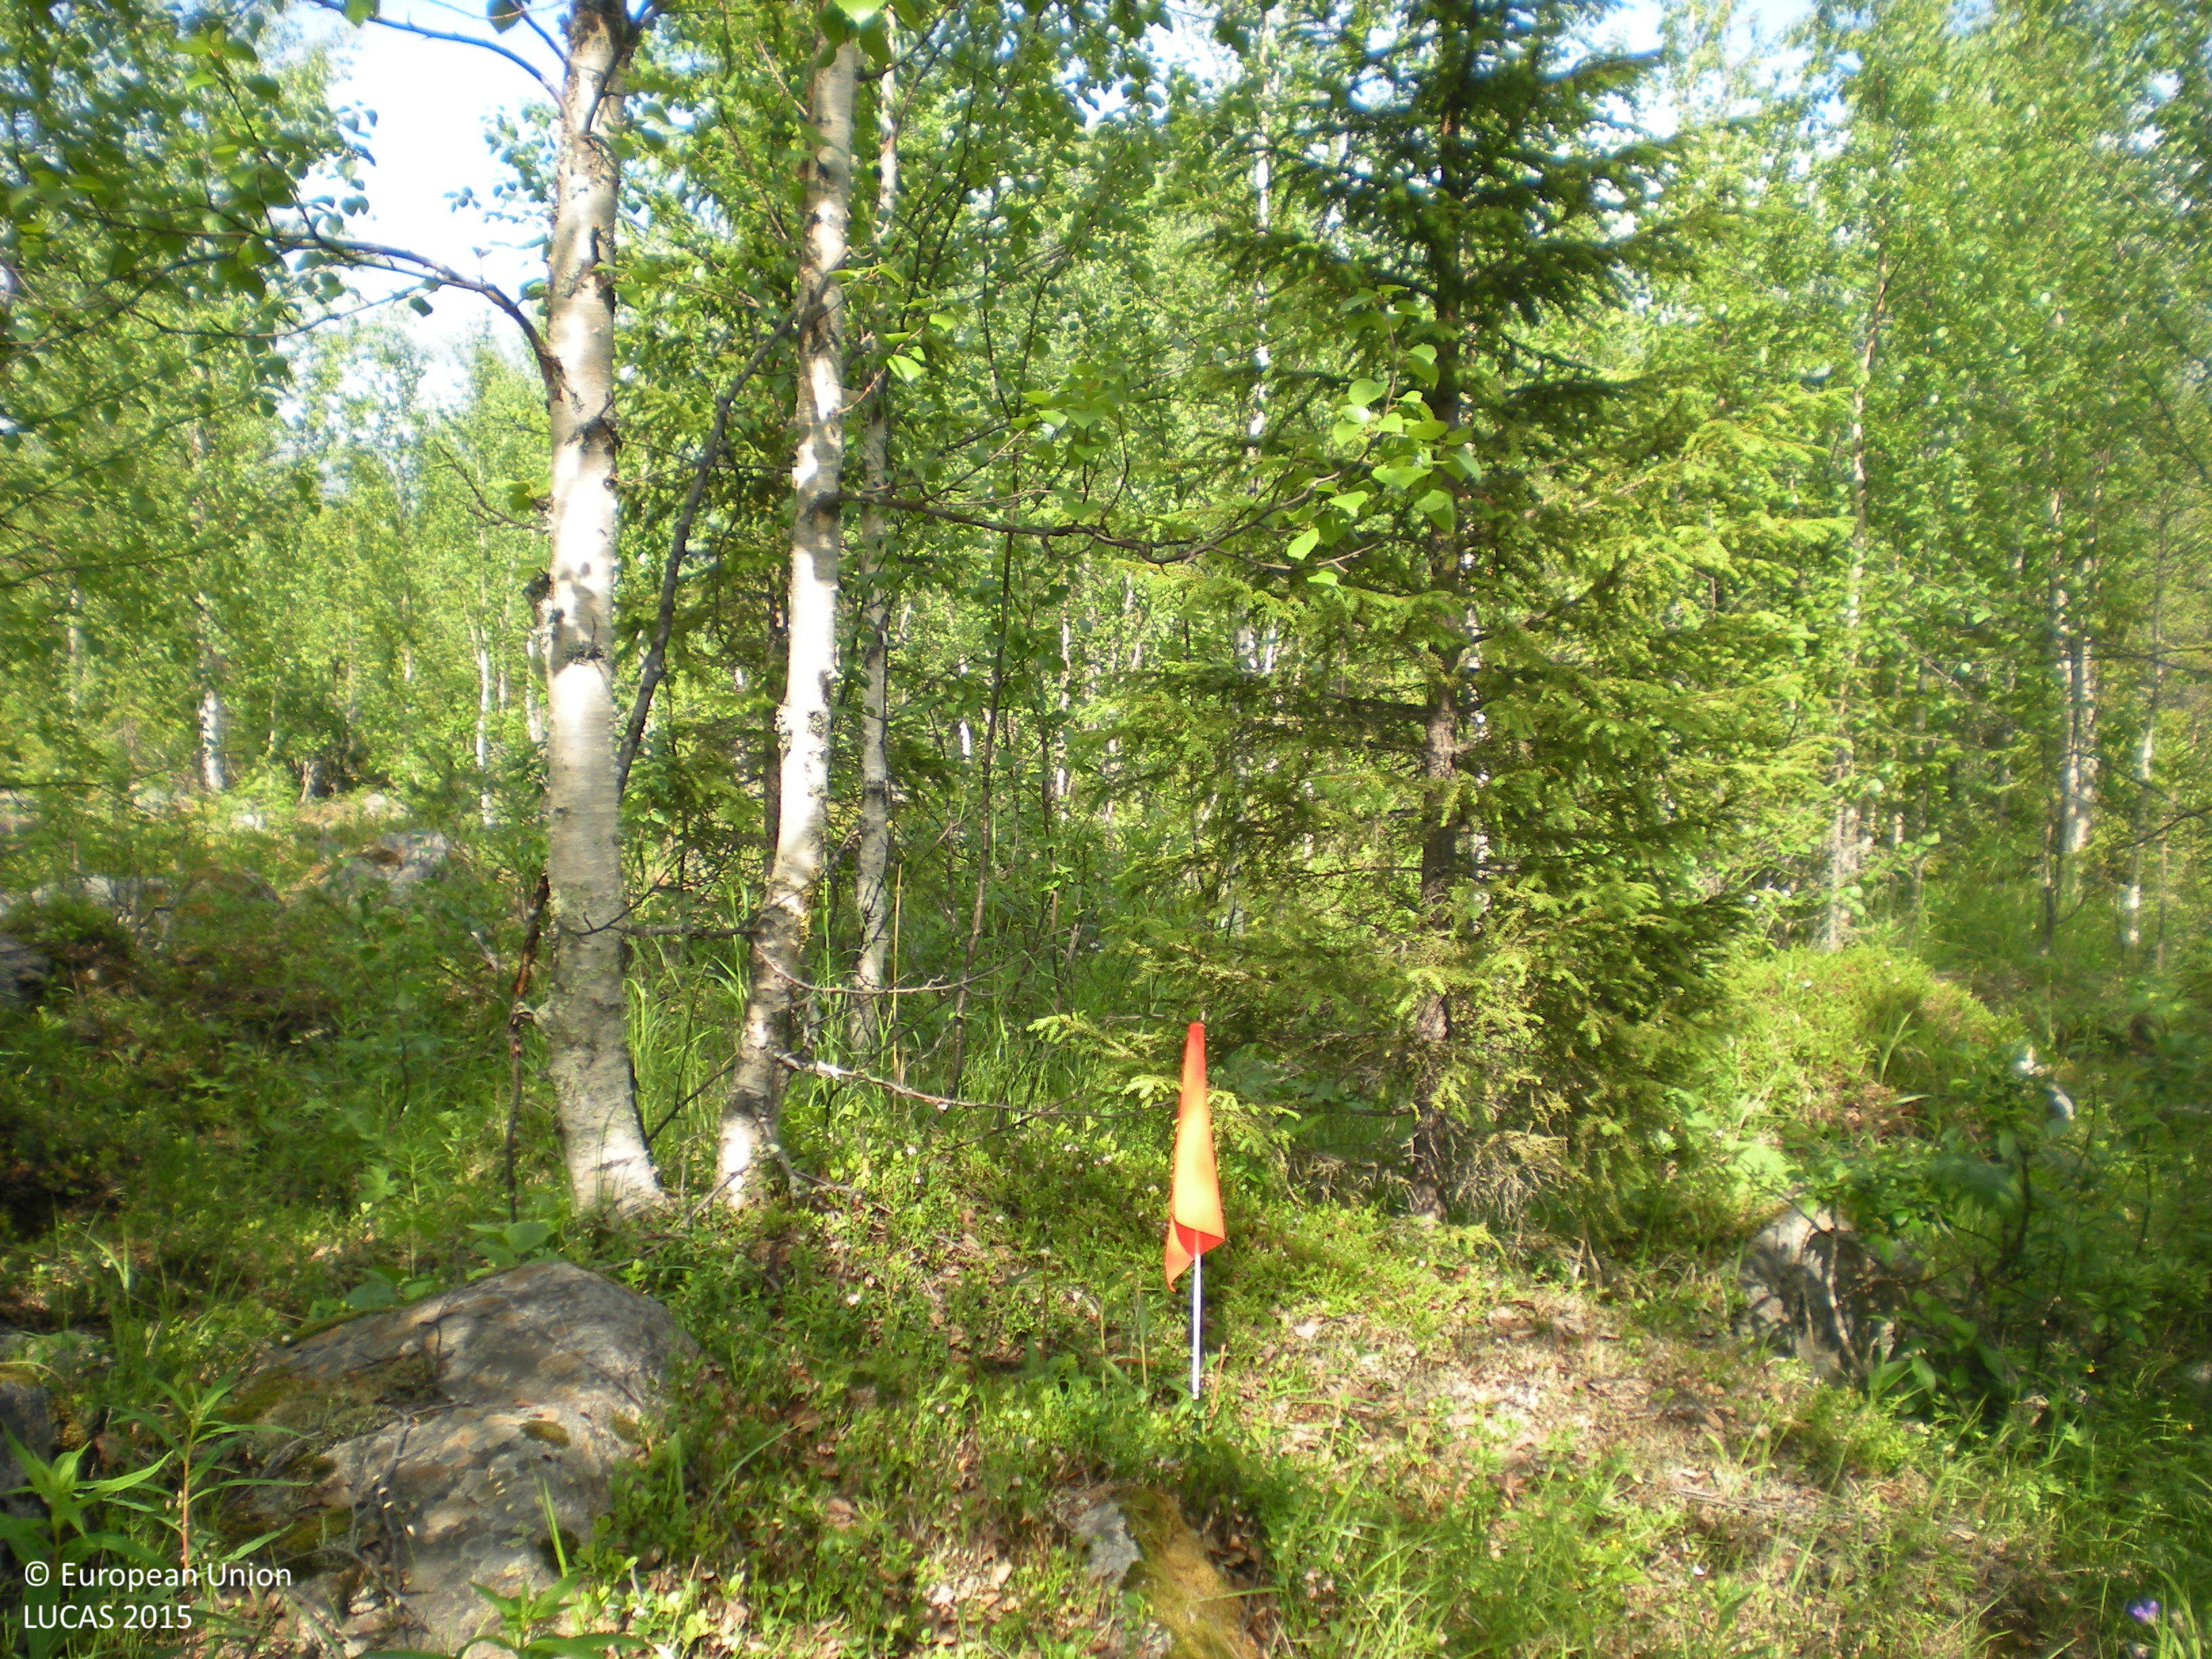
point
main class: Woodland
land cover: Spruce dominated mixed woodland
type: boreal forest
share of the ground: 50 - 75 %
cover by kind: broadleaved forest trees 50 %, coniferous forest trees 20 %, consolidated bare surface 15 %, herbaceous plants 10 %, shrubs 5 %
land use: Forestry
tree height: < 5 m
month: July
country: SE
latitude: 65.5720
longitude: 16.9164
